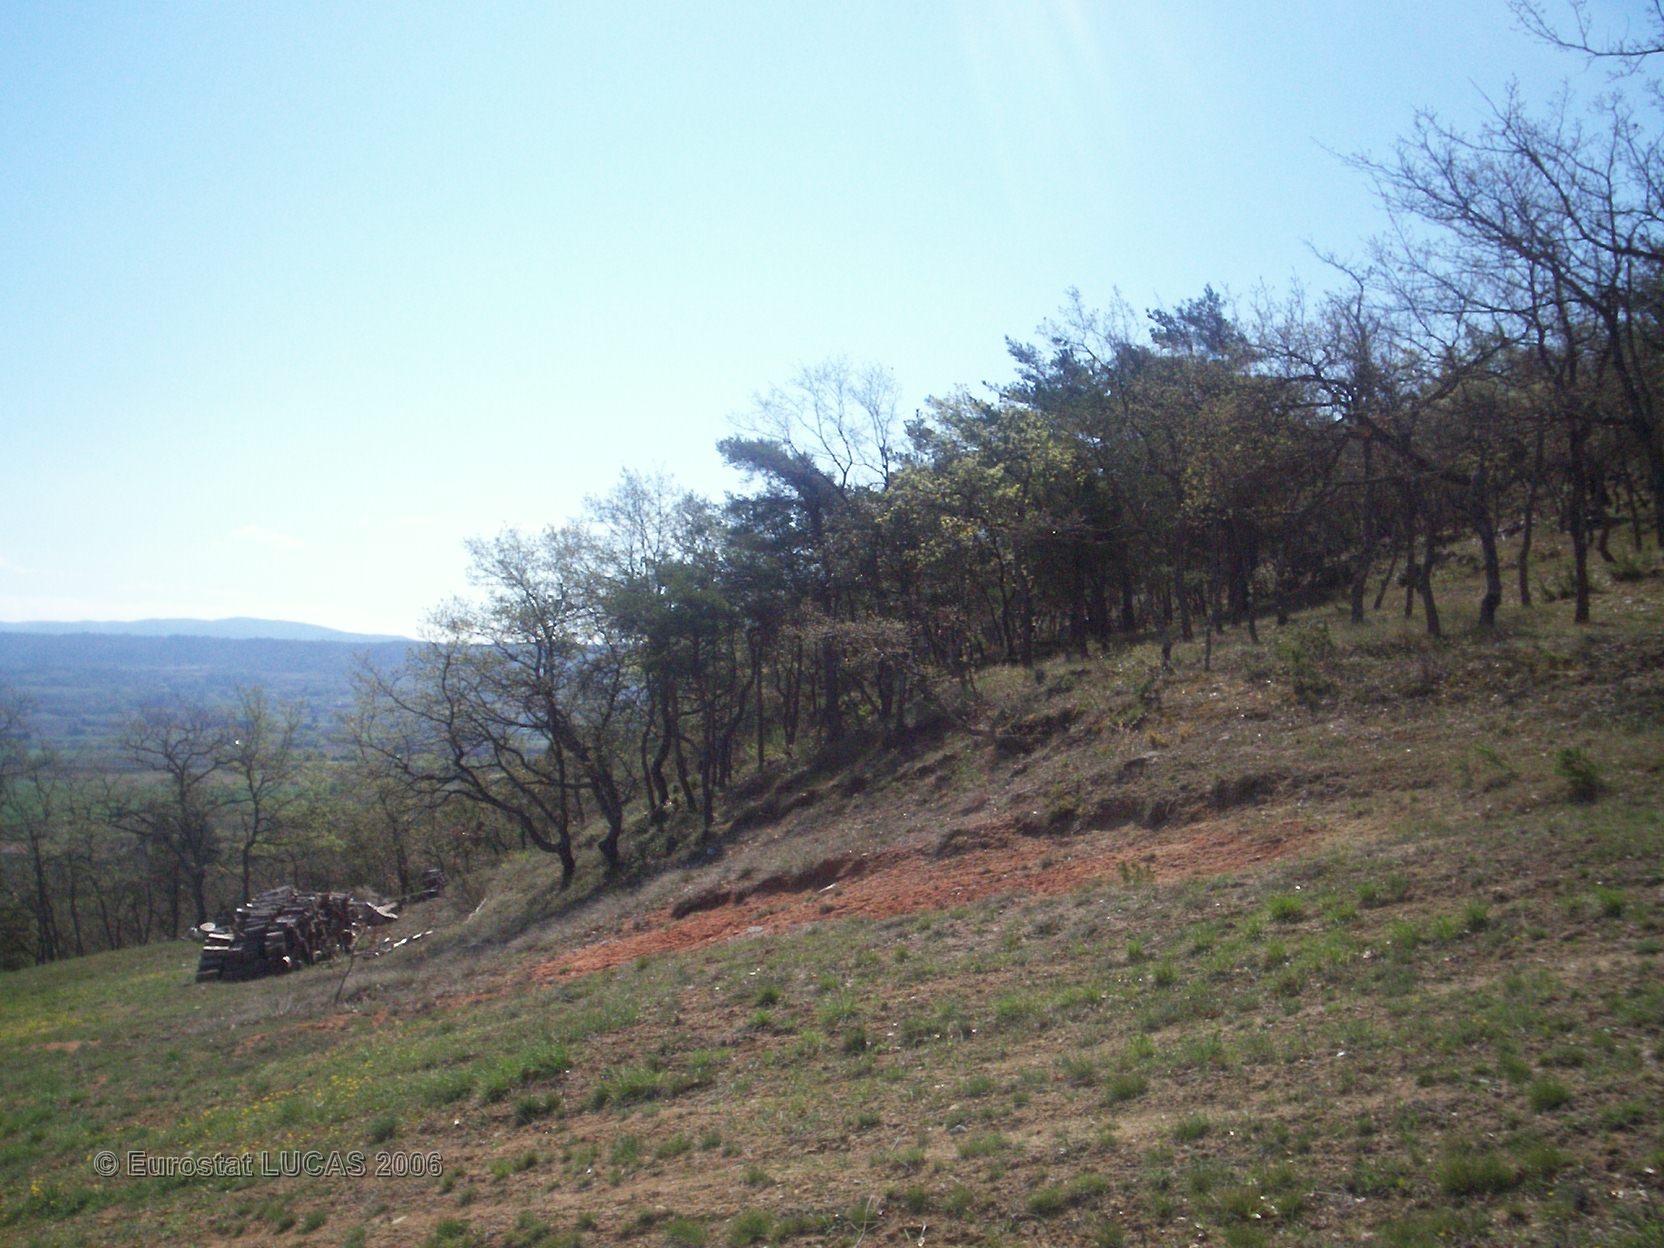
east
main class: Grassland
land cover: Grassland without tree/shrub cover
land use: Agriculture (excluding fallow land and kitchen gardens)
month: April
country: FR
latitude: 43.8452
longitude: 5.2697
